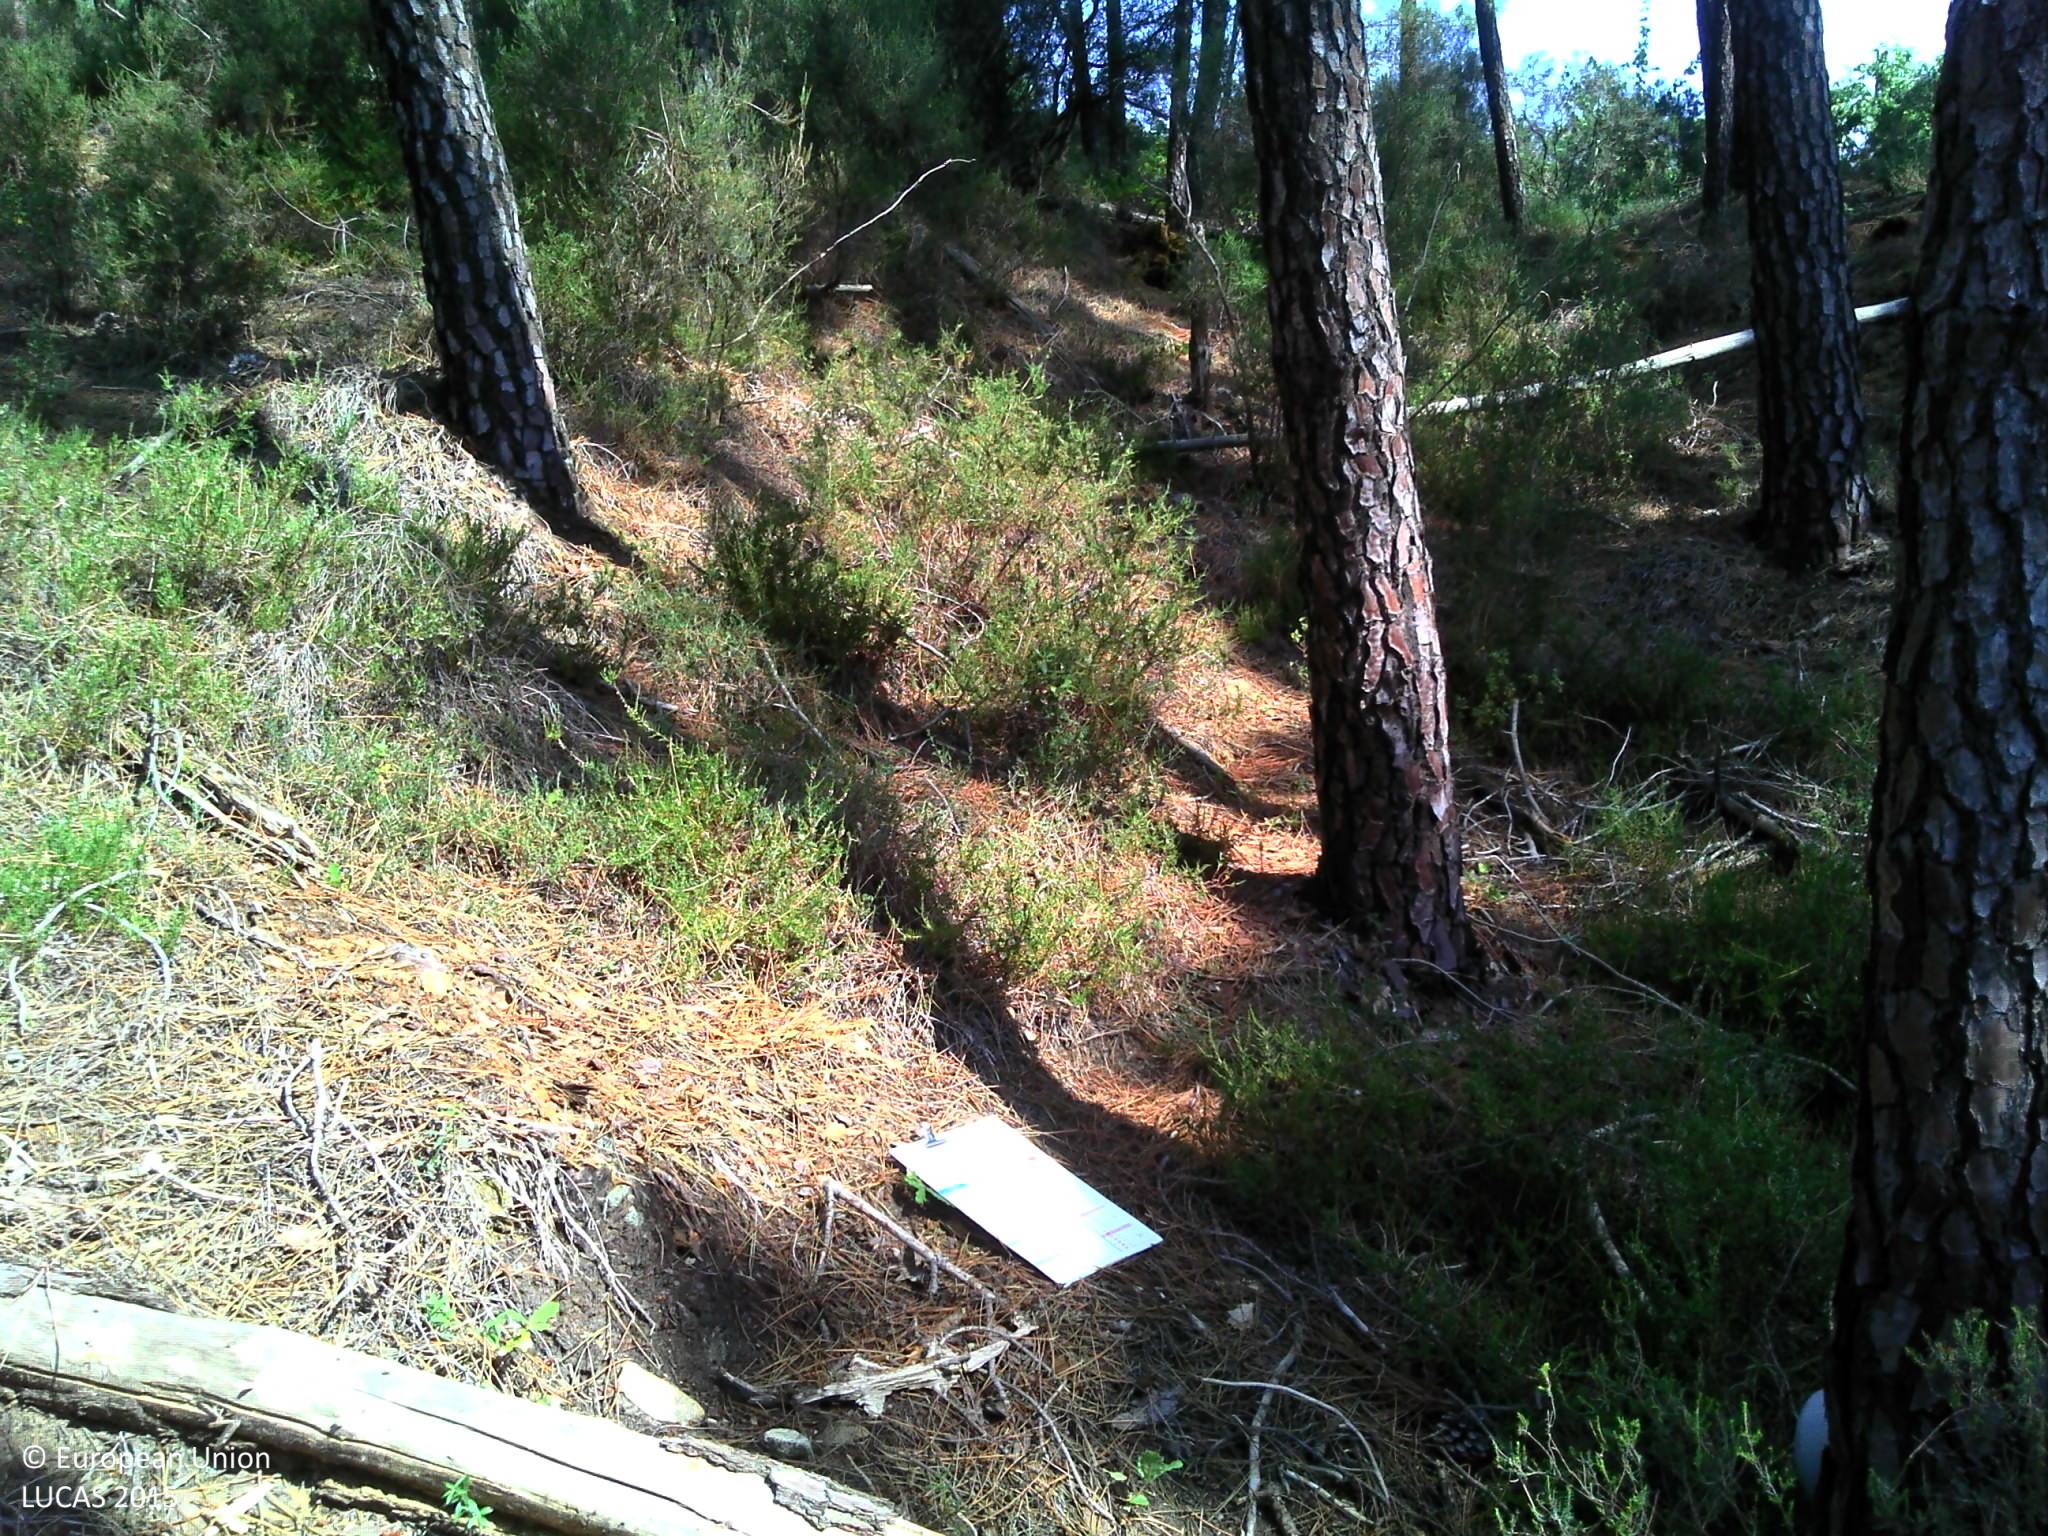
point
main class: Woodland
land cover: Pine dominated coniferous woodland
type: coniferous forest of the mediterranean region
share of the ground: > 75 %
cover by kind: coniferous forest trees 75 %, shrubs 15 %, herbaceous plants 10 %
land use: Forestry
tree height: > 5 m
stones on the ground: 10 - 25 %
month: July
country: FR
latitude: 44.0781
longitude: 5.2256
